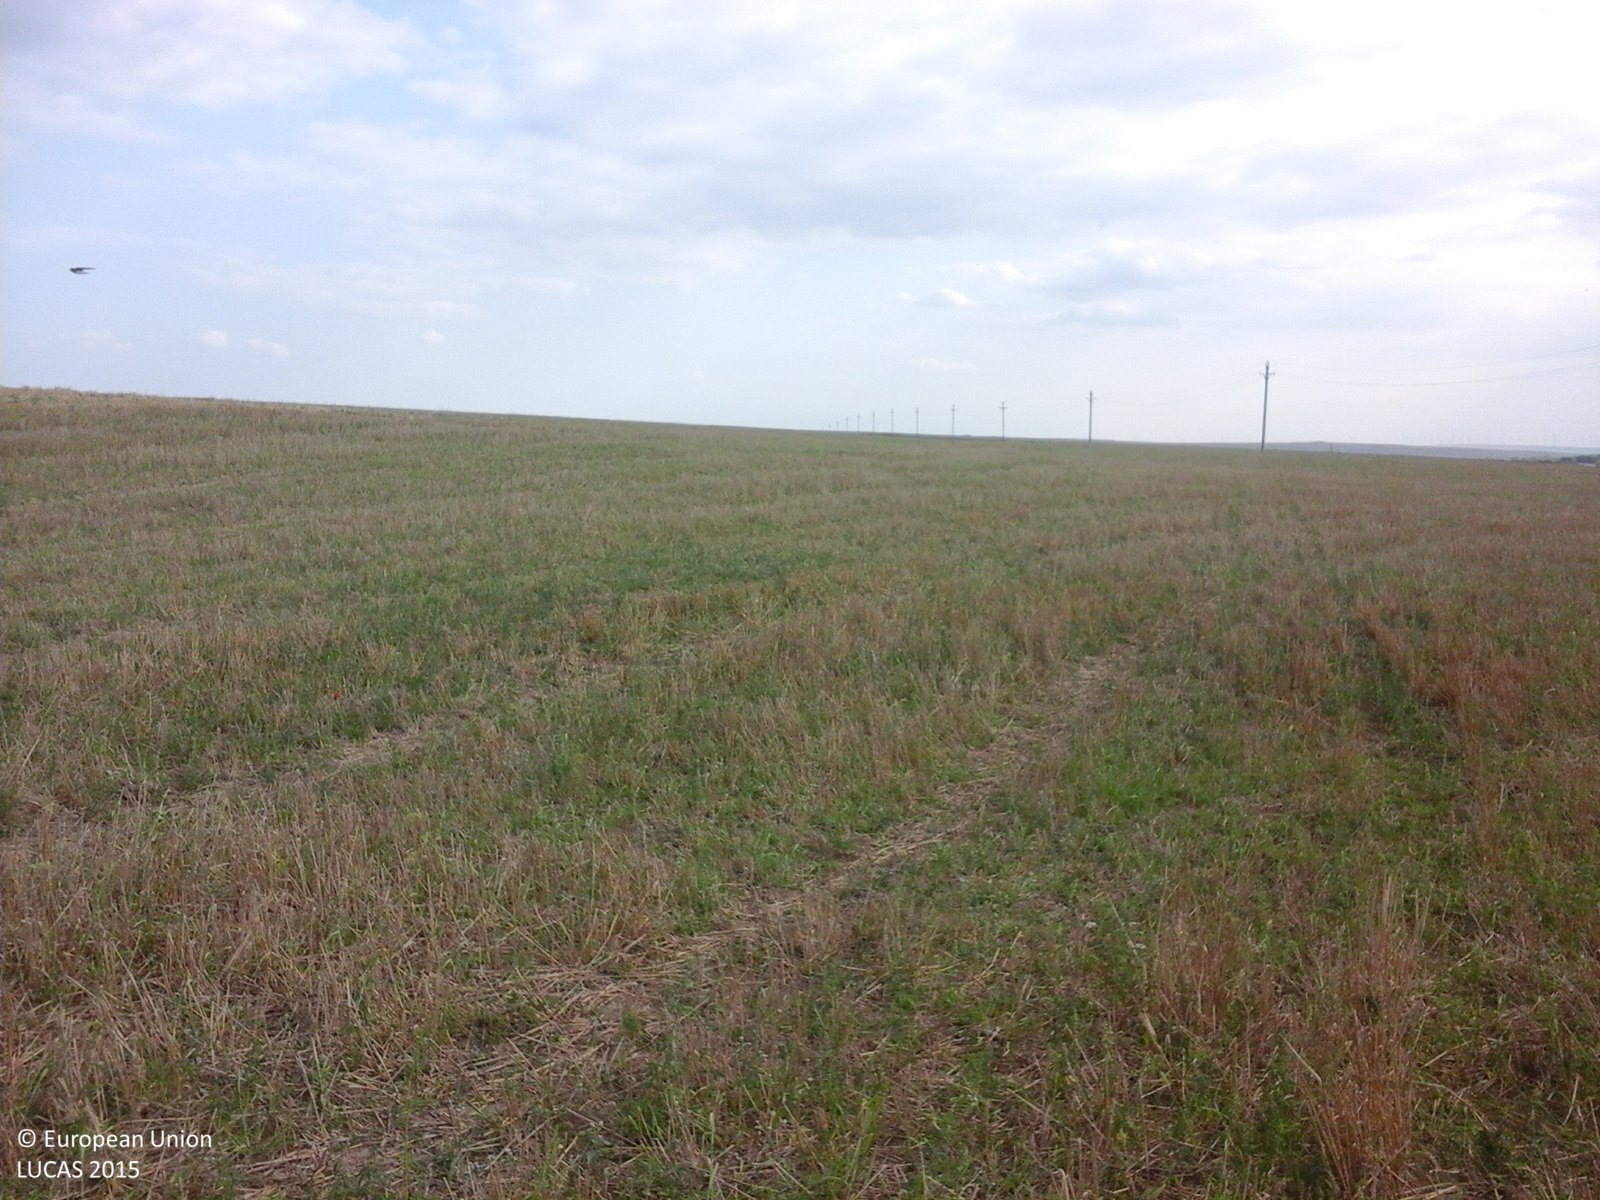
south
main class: Cropland
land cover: Triticale
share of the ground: > 75 %
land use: Agriculture (excluding fallow land and kitchen gardens)
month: August
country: RO
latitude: 44.6503
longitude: 28.4709
